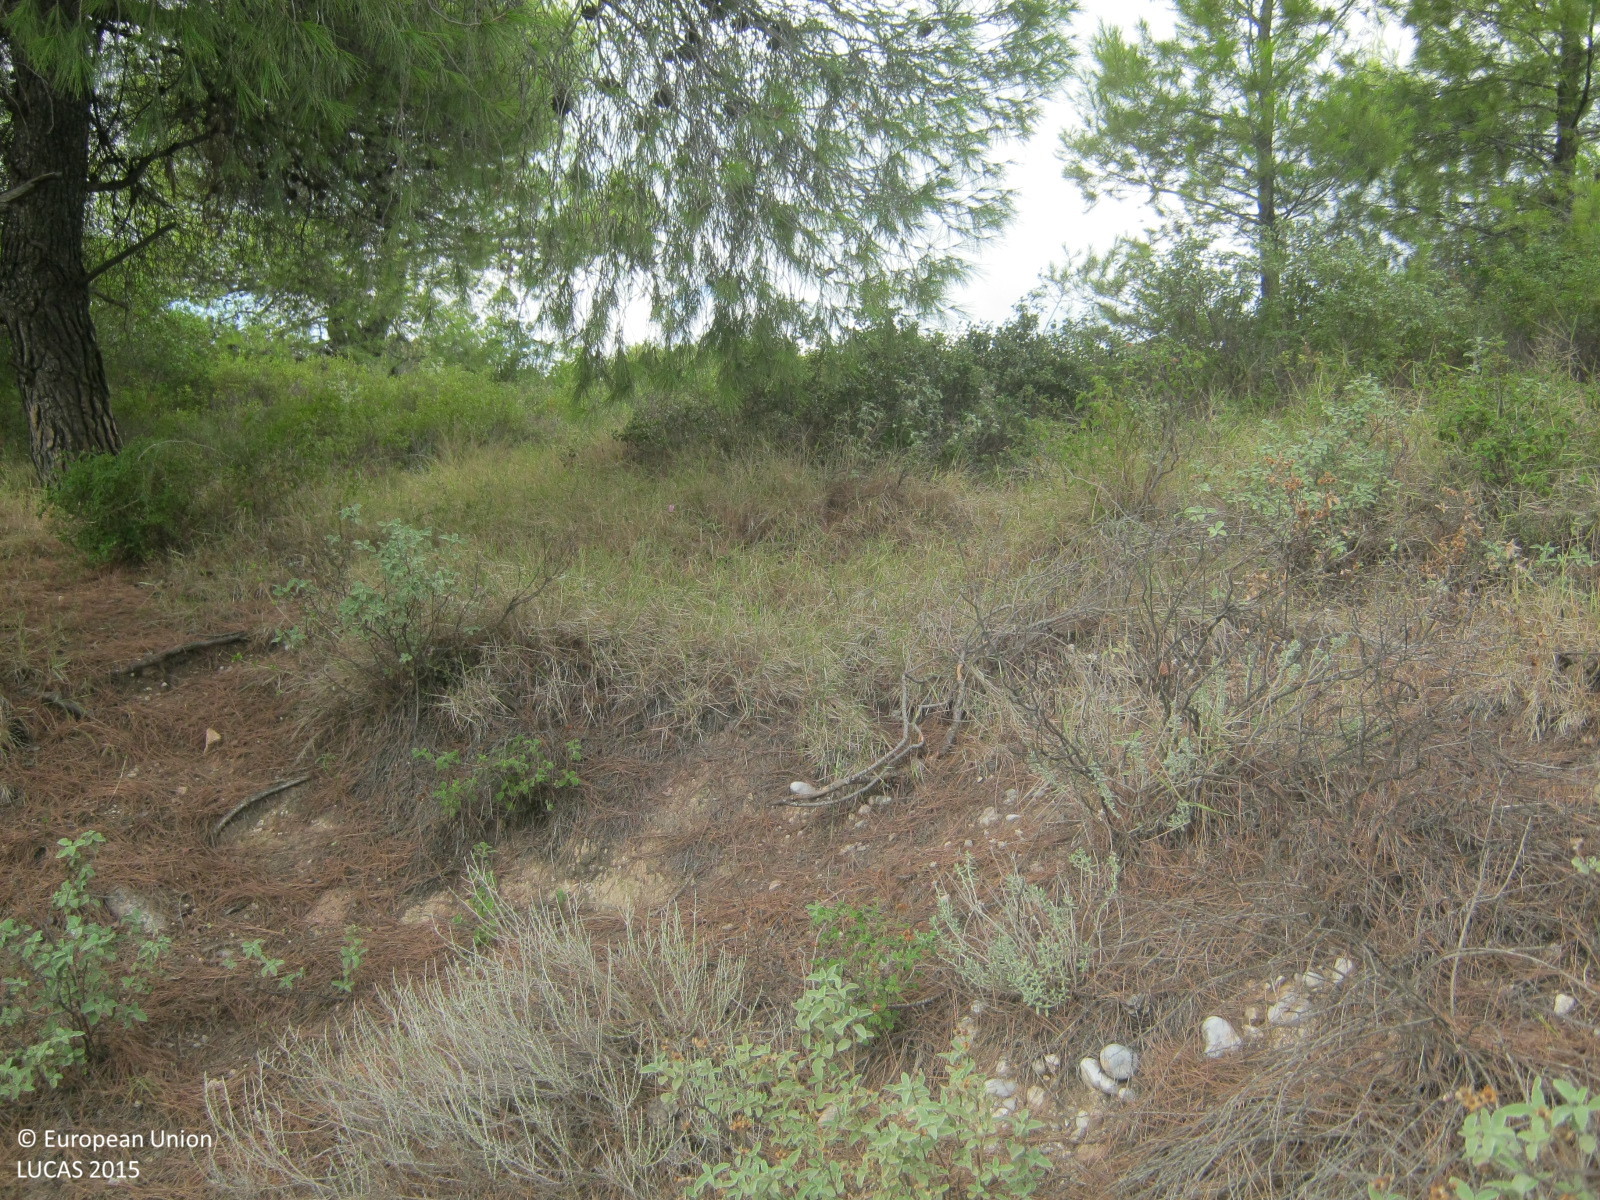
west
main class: Woodland
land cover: Pine dominated coniferous woodland
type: coniferous forest of the mediterranean region
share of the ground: 50 - 75 %
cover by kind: coniferous forest trees 50 %, shrubs 40 %, unconsolidated bare surface 10 %
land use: Semi-natural and natural areas not in use
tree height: < 5 m
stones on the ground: < 10 %
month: October
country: GR
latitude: 38.3908
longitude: 23.5286
